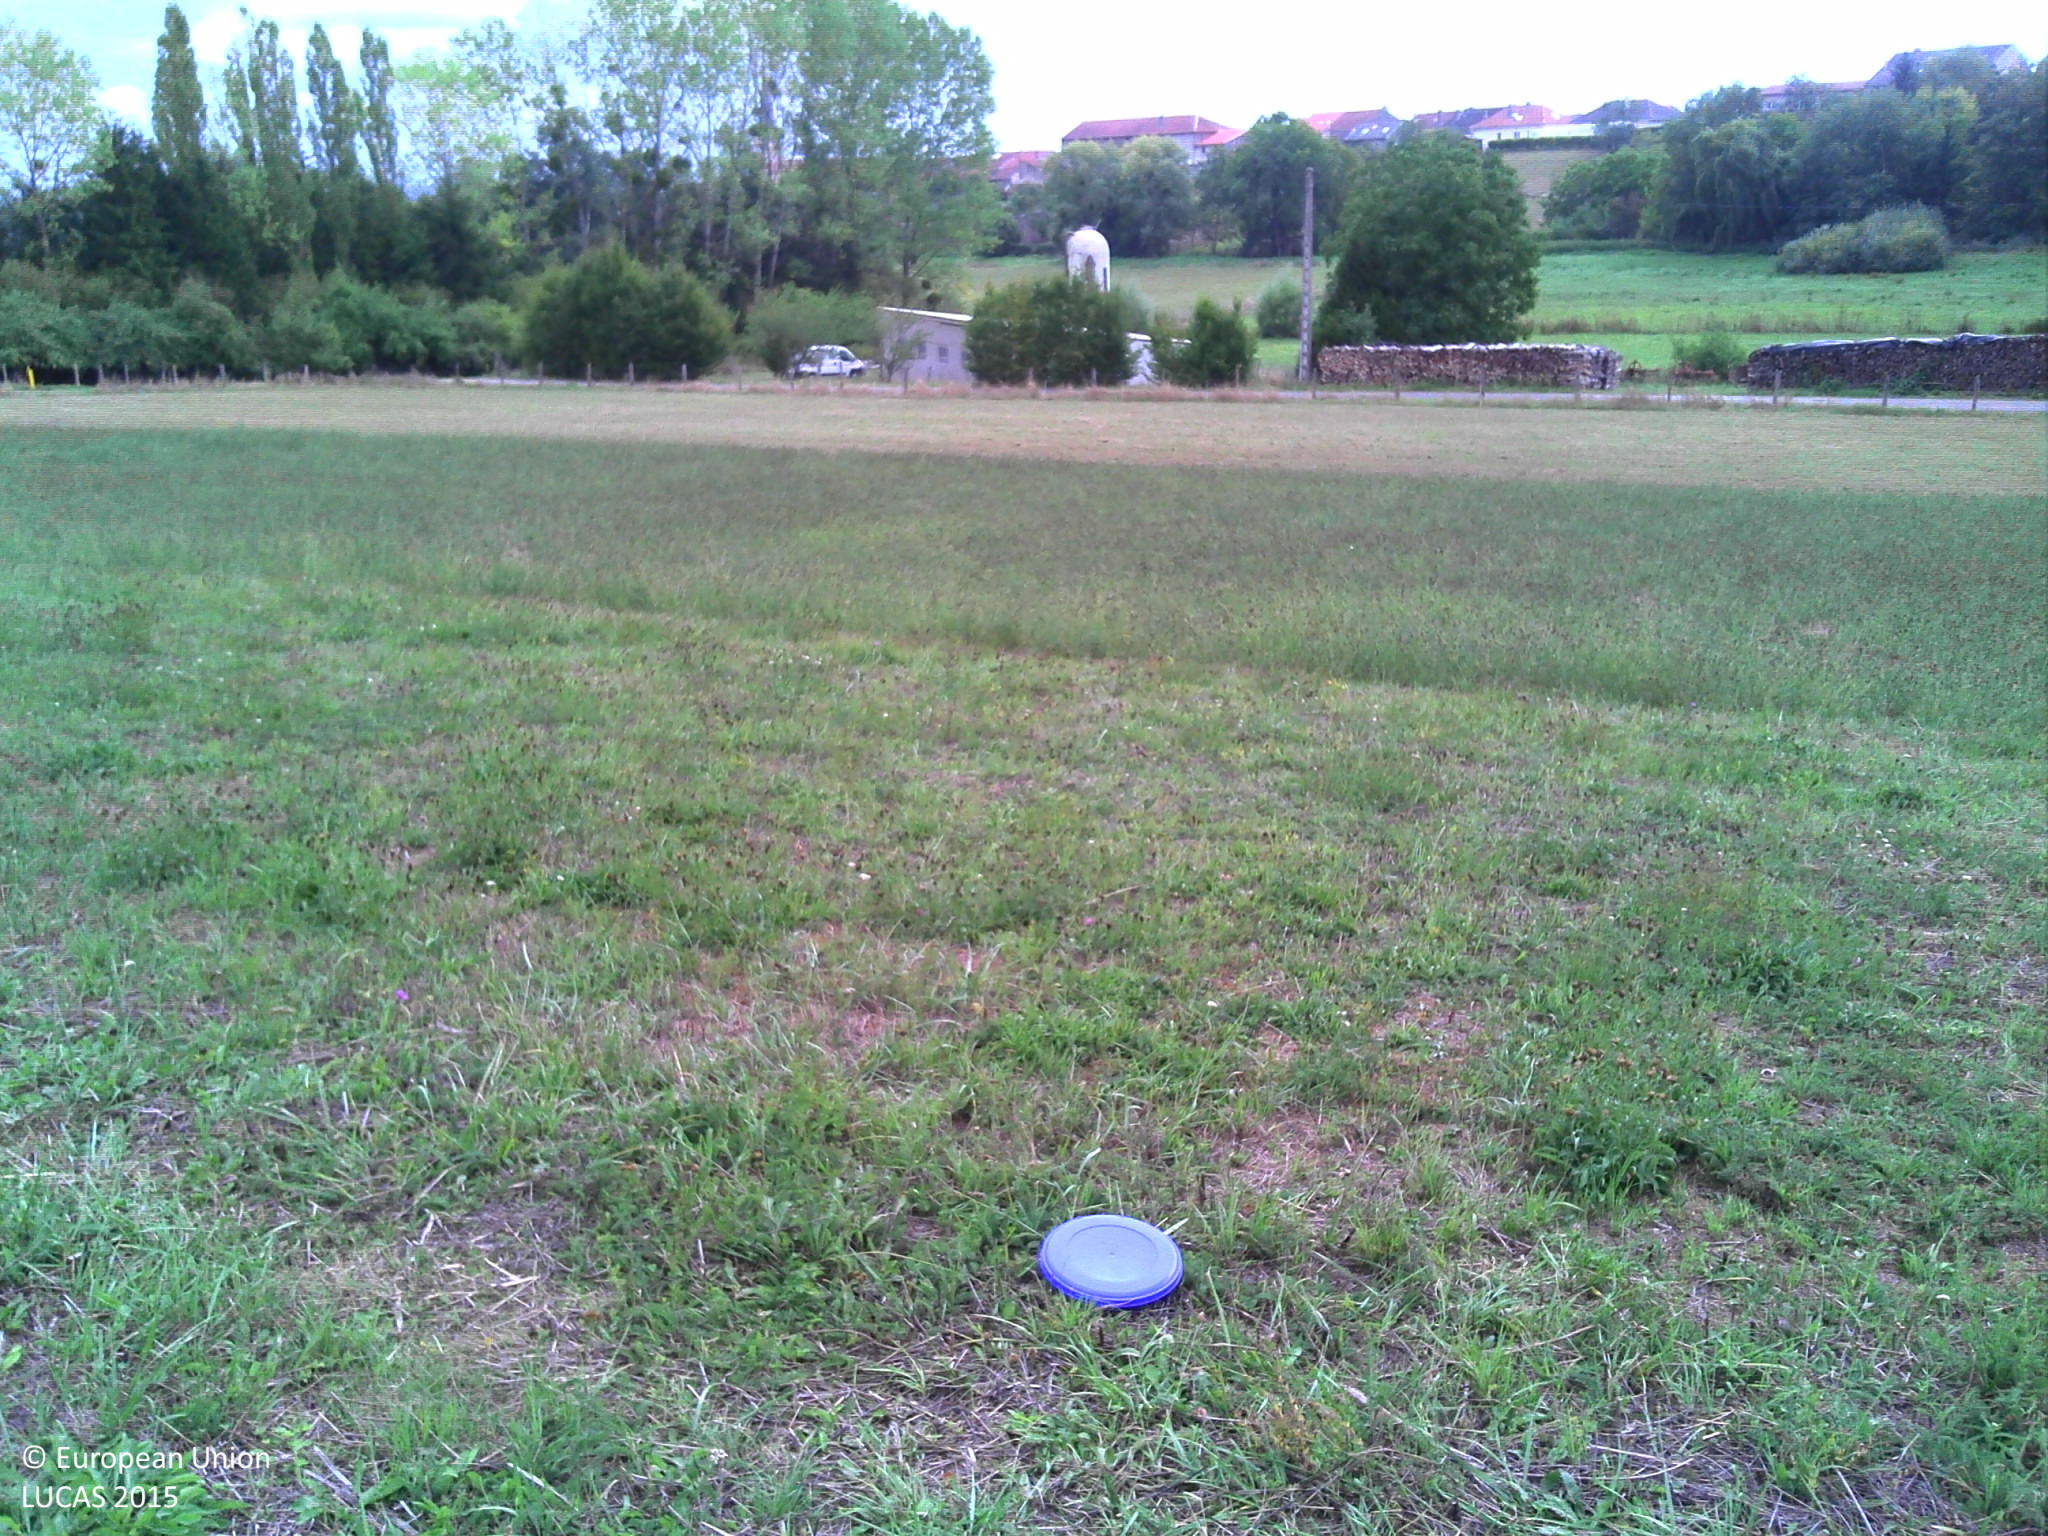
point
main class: Cropland
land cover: Temporary grasslands
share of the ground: > 75 %
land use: Agriculture (excluding fallow land and kitchen gardens)
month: September
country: FR
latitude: 48.5853
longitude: 6.0550
